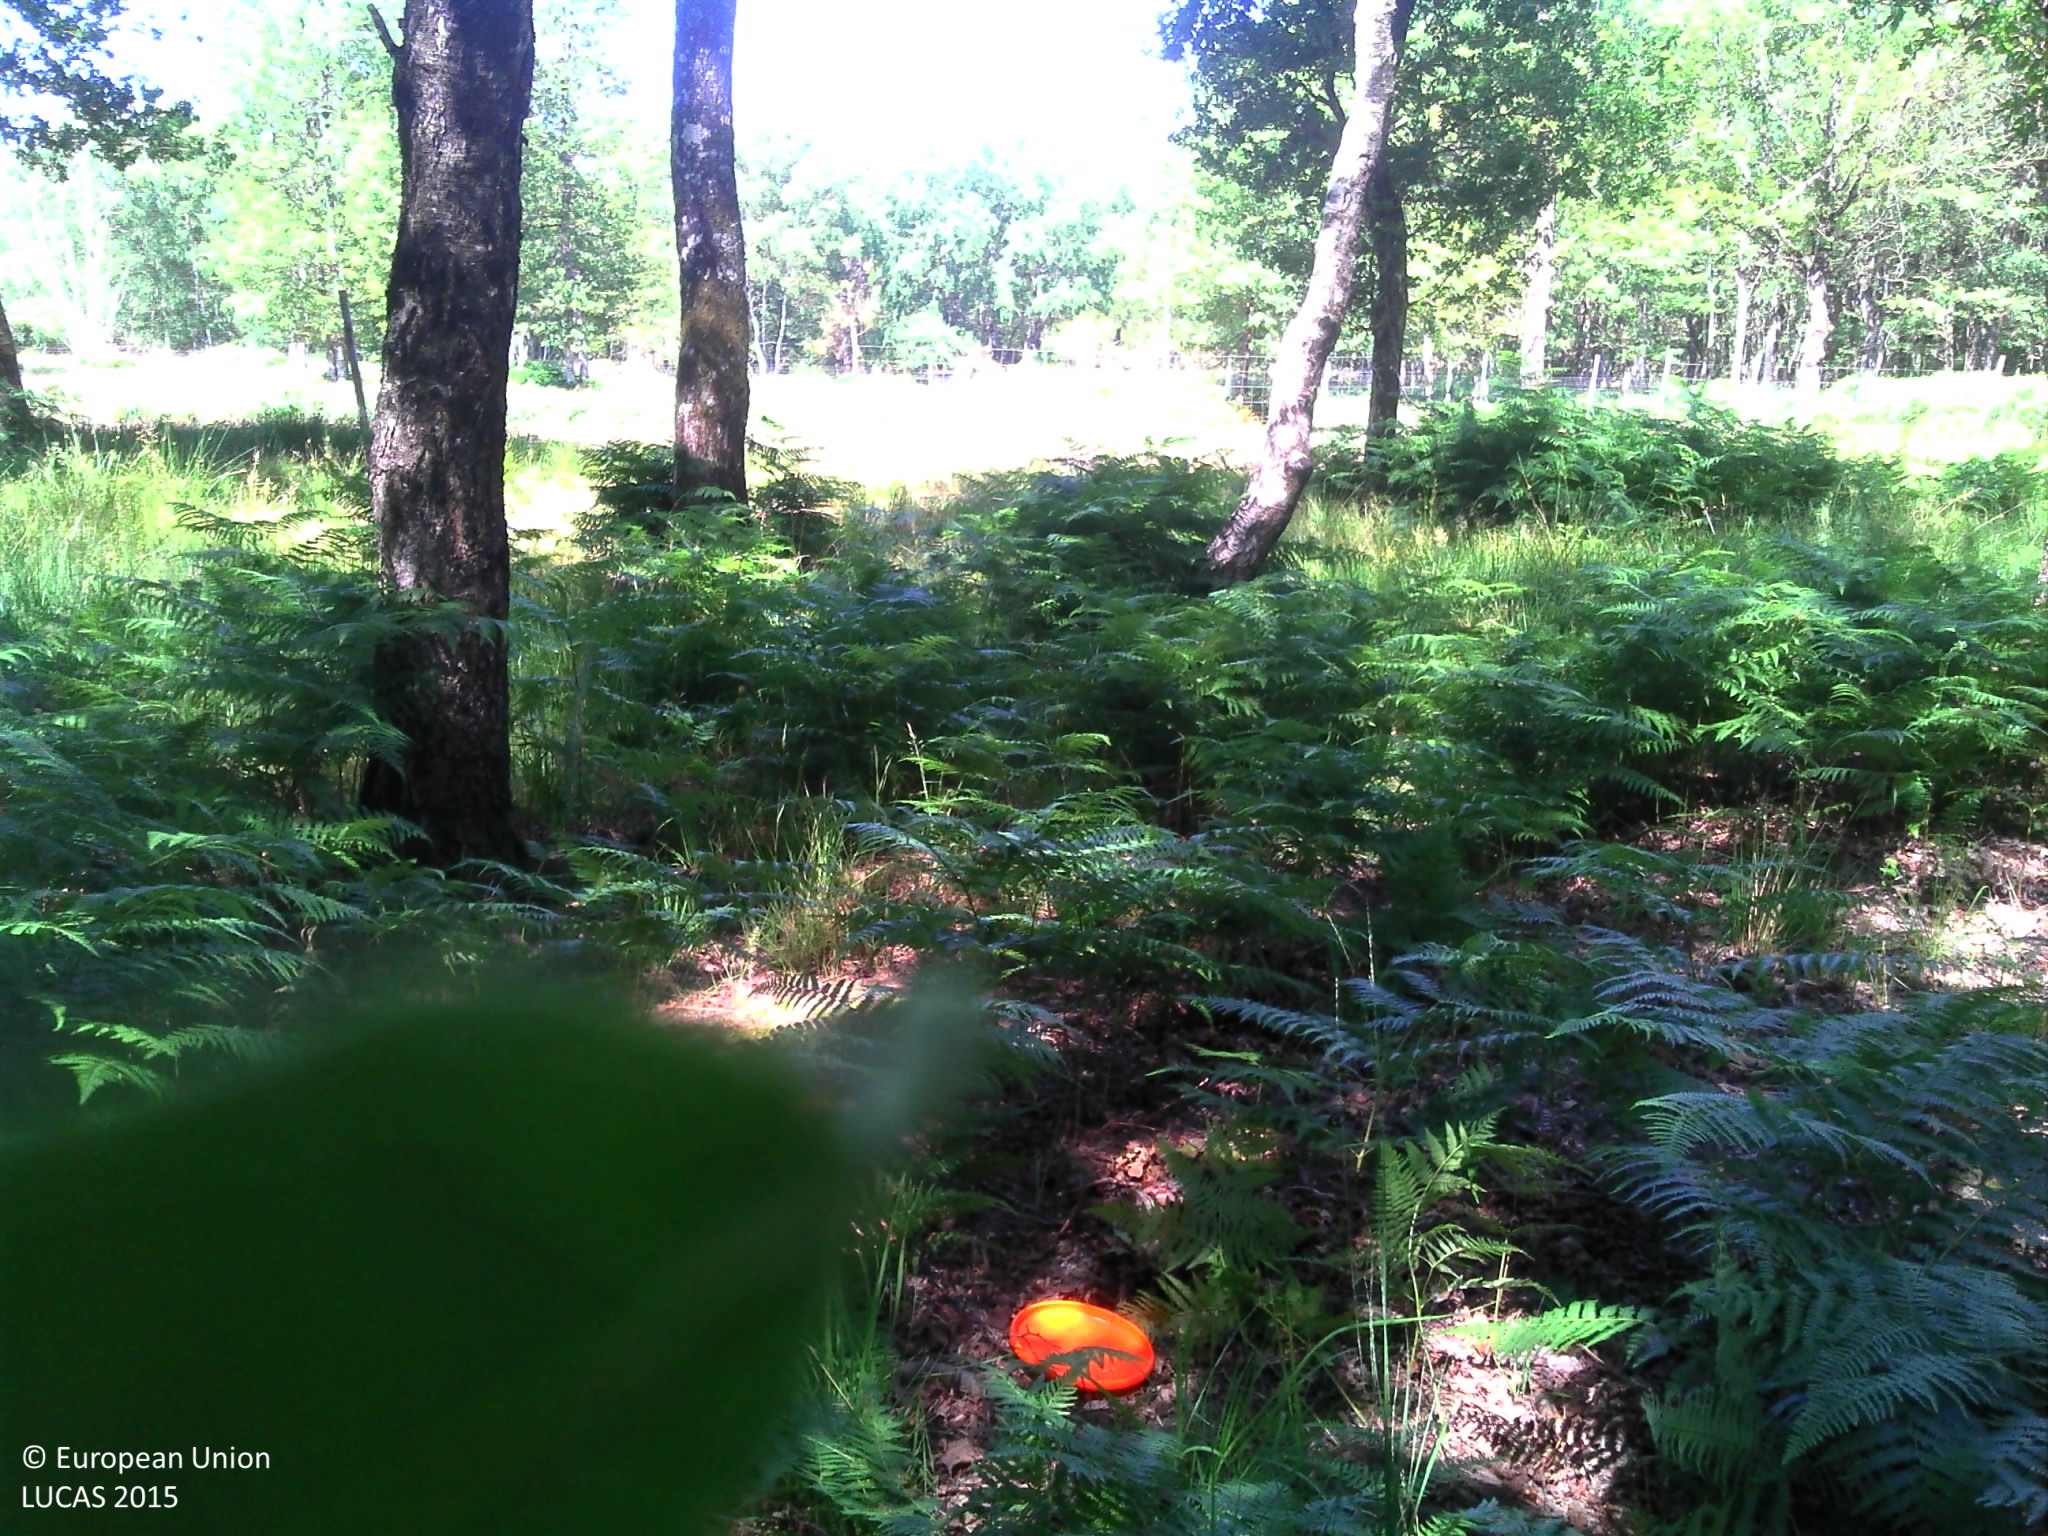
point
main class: Woodland
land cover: Broadleaved woodland
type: mesophytic deciduous forest
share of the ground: > 75 %
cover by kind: broadleaved forest trees 70 %, herbaceous plants 20 %, shrubs 5 %, lichens and mosses 5 %
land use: Forestry
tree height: > 5 m
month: June
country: FR
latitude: 47.3621
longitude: 0.3251
